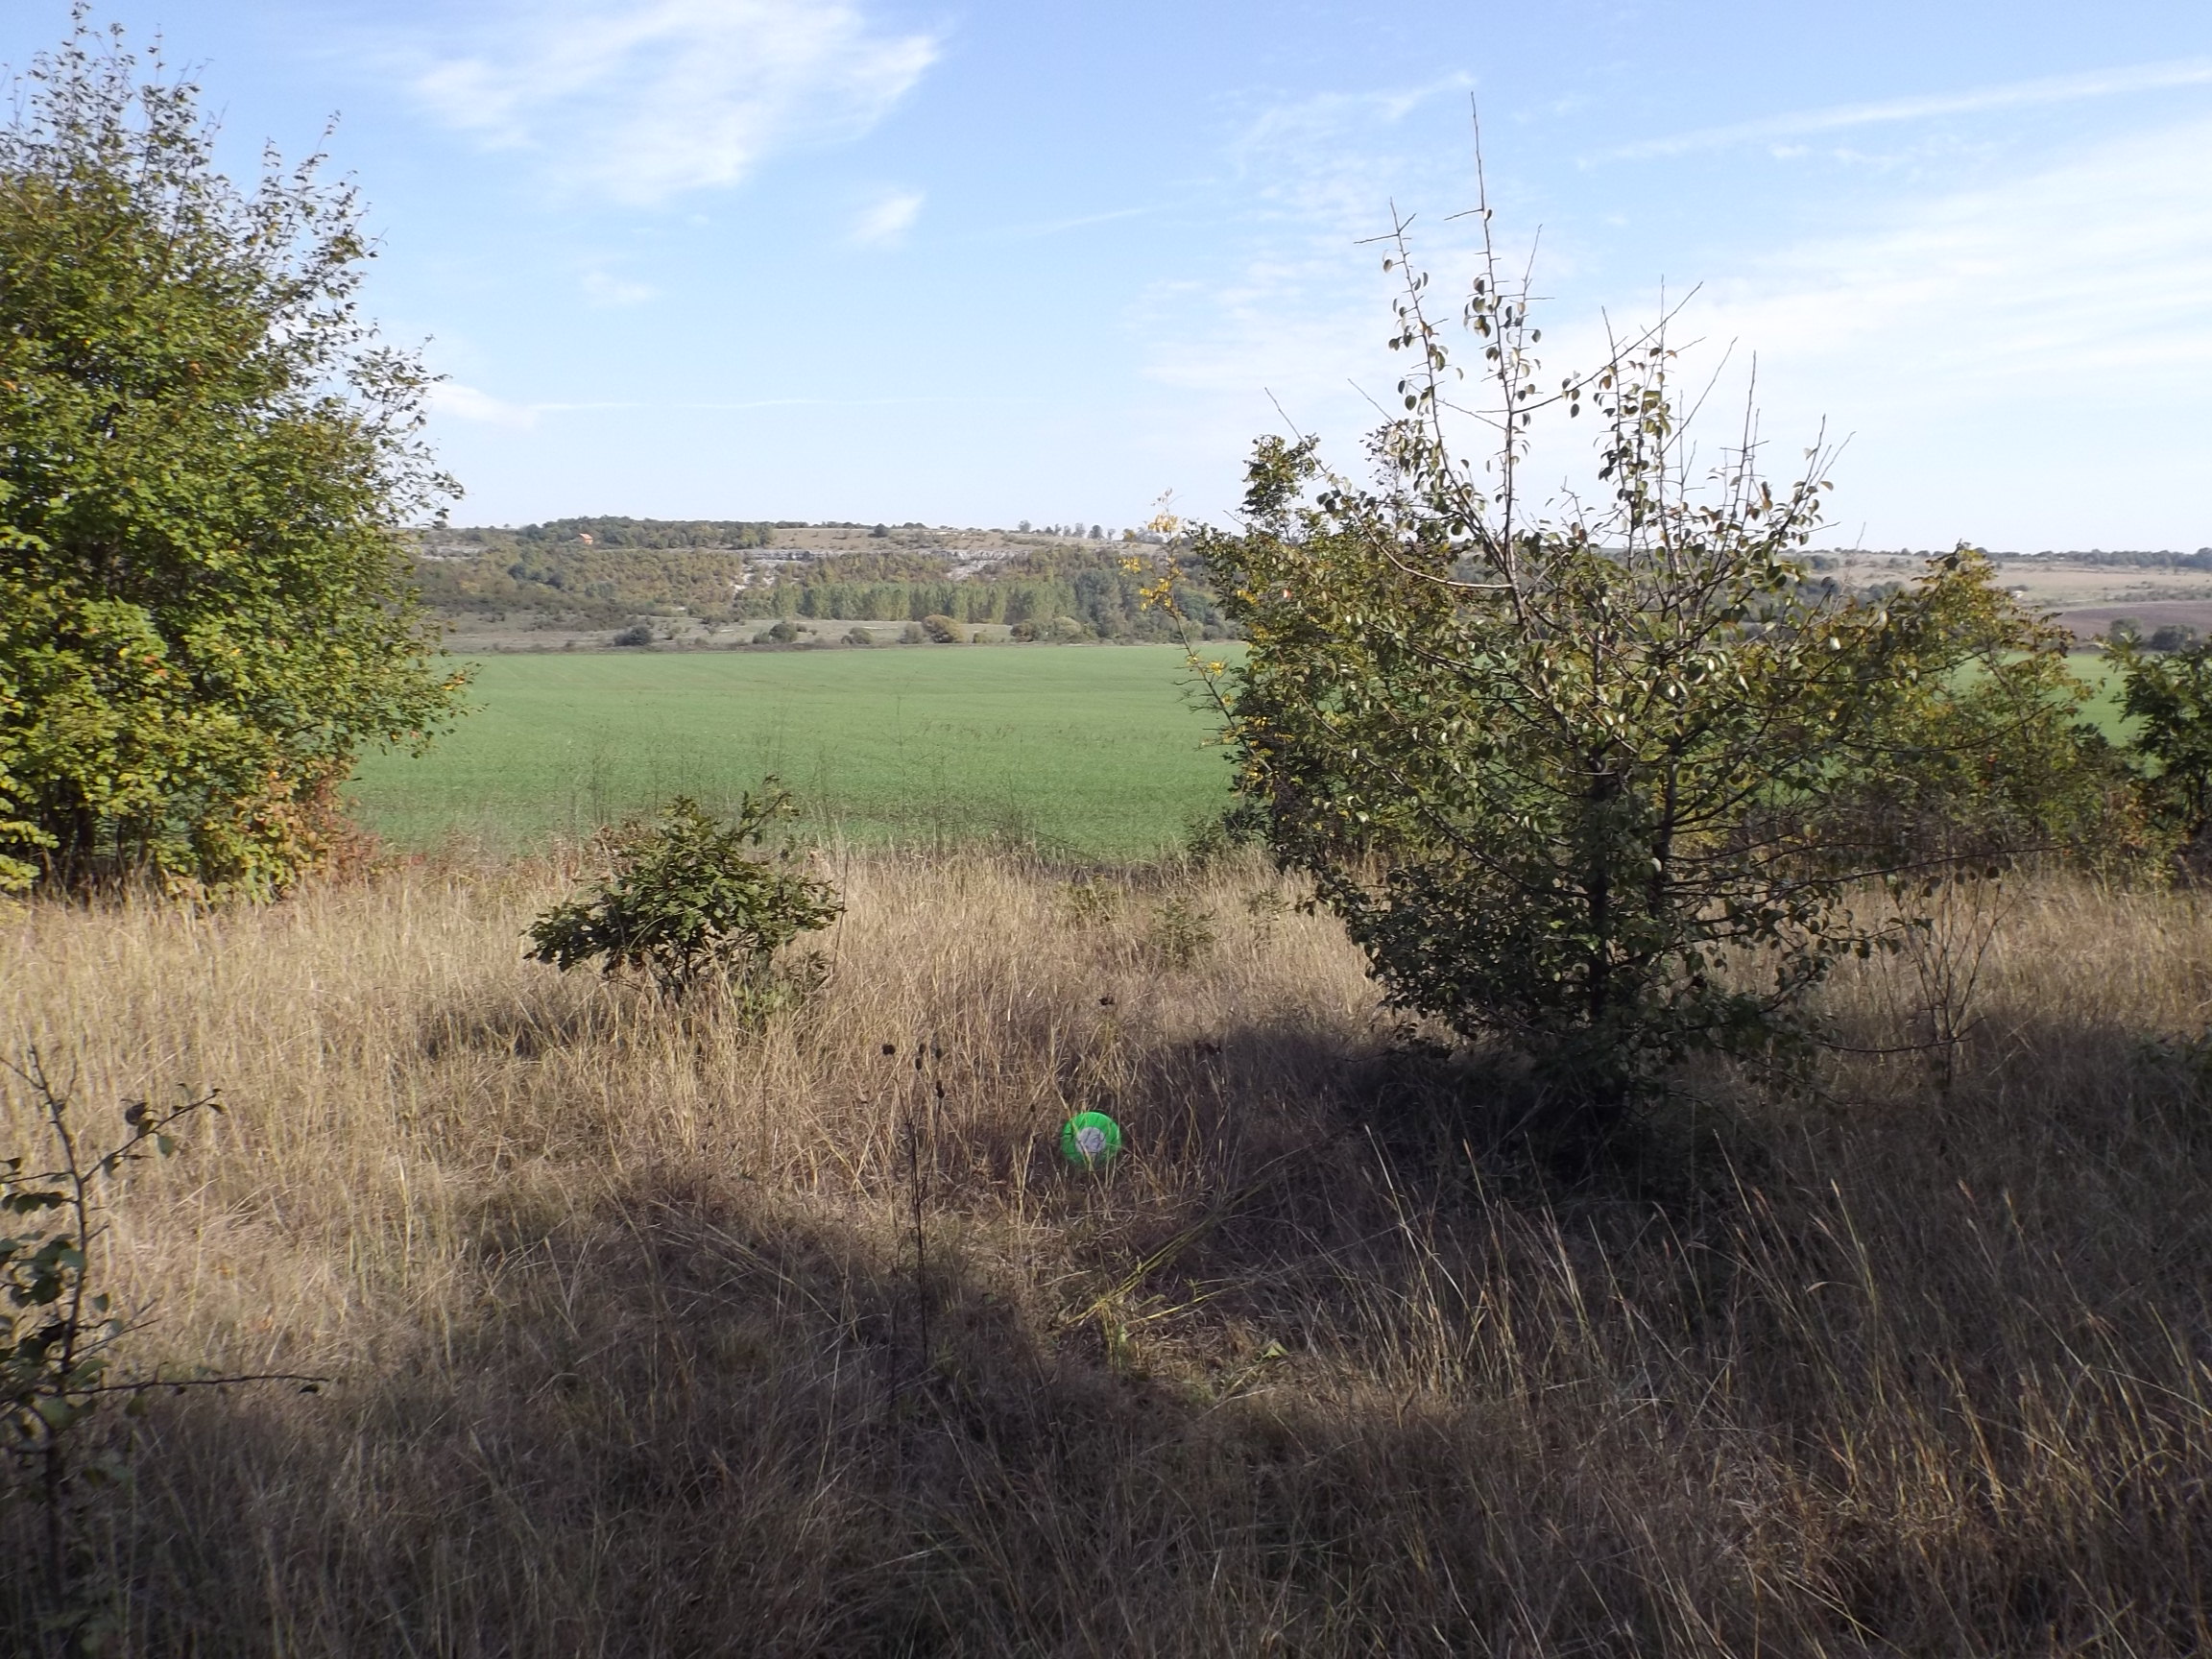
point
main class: Grassland
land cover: Grassland with sparse tree/shrub cover
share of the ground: > 75 %
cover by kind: herbaceous plants 90 %, broadleaved forest trees 5 %, shrubs 5 %
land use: Semi-natural and natural areas not in use
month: October
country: BG
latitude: 43.1546
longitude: 27.2251
